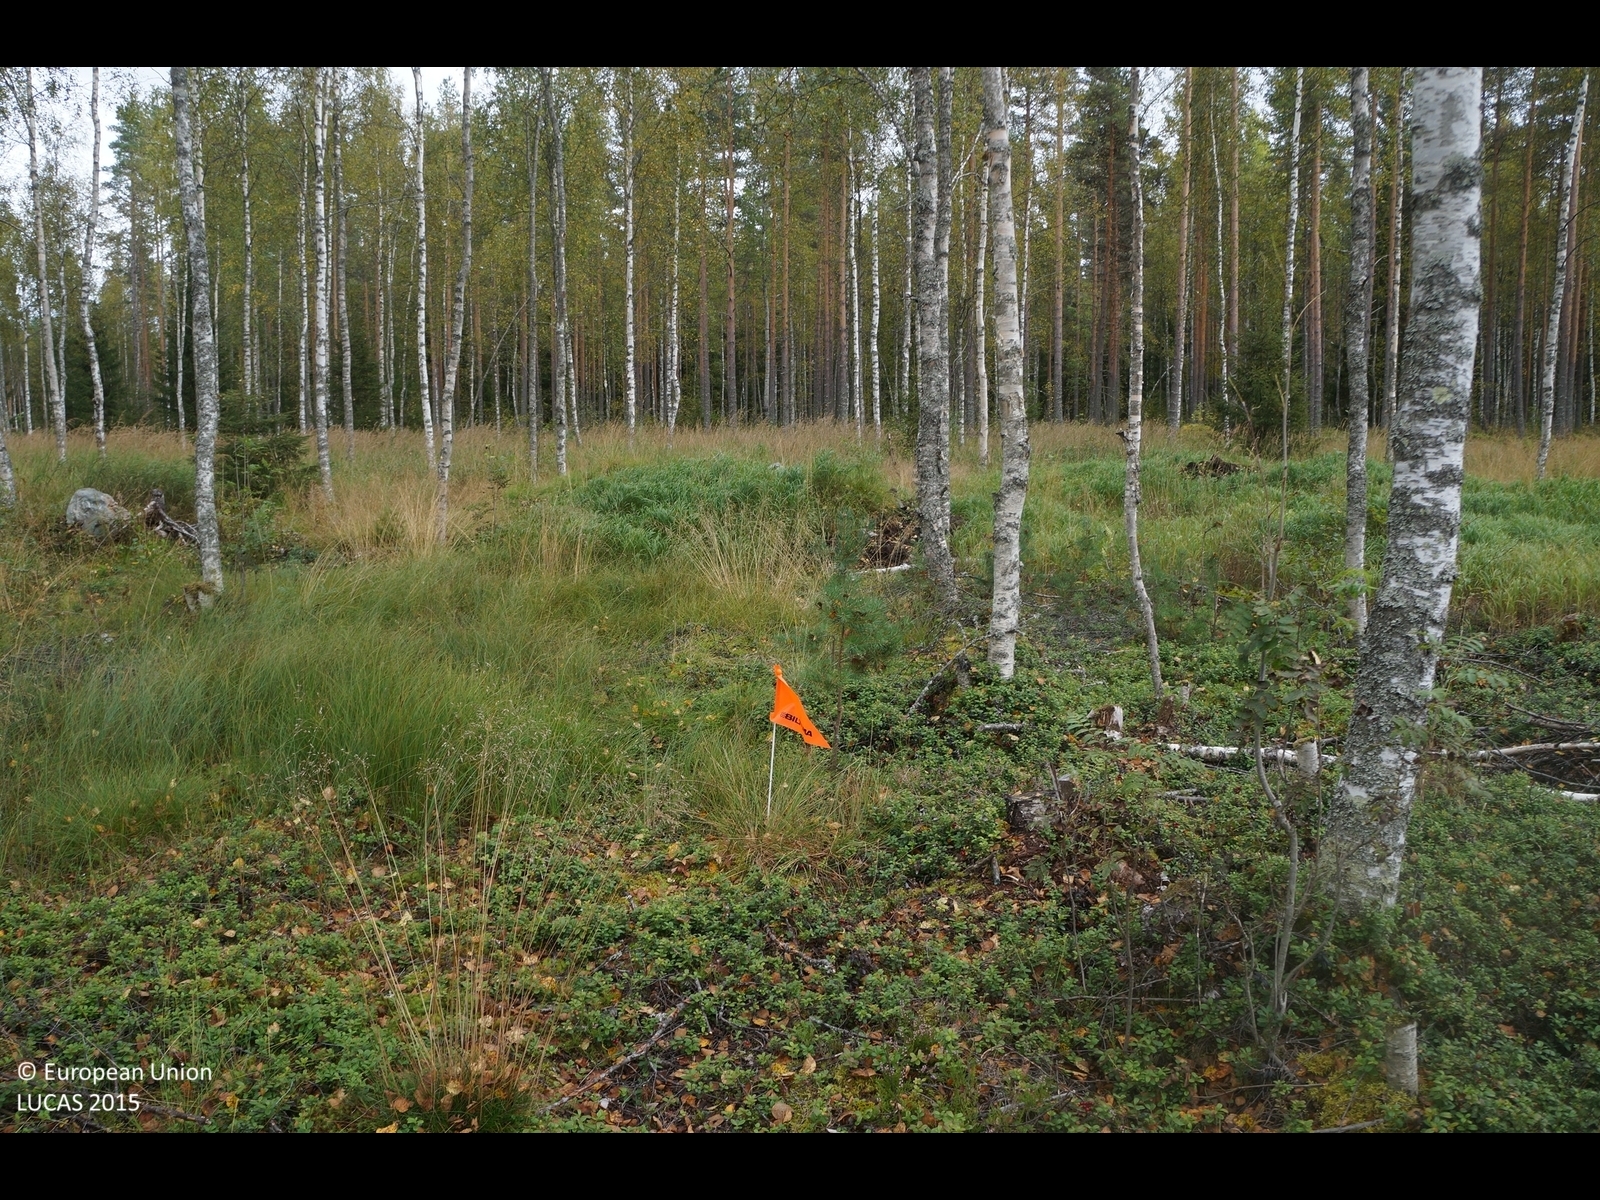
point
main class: Woodland
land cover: Broadleaved woodland
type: non-riverine alder, birch or aspen forest
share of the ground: 50 - 75 %
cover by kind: broadleaved forest trees 50 %, shrubs 20 %, herbaceous plants 20 %, lichens and mosses 10 %
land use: Forestry
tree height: > 5 m
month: September
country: FI
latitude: 64.0370
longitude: 24.3408
